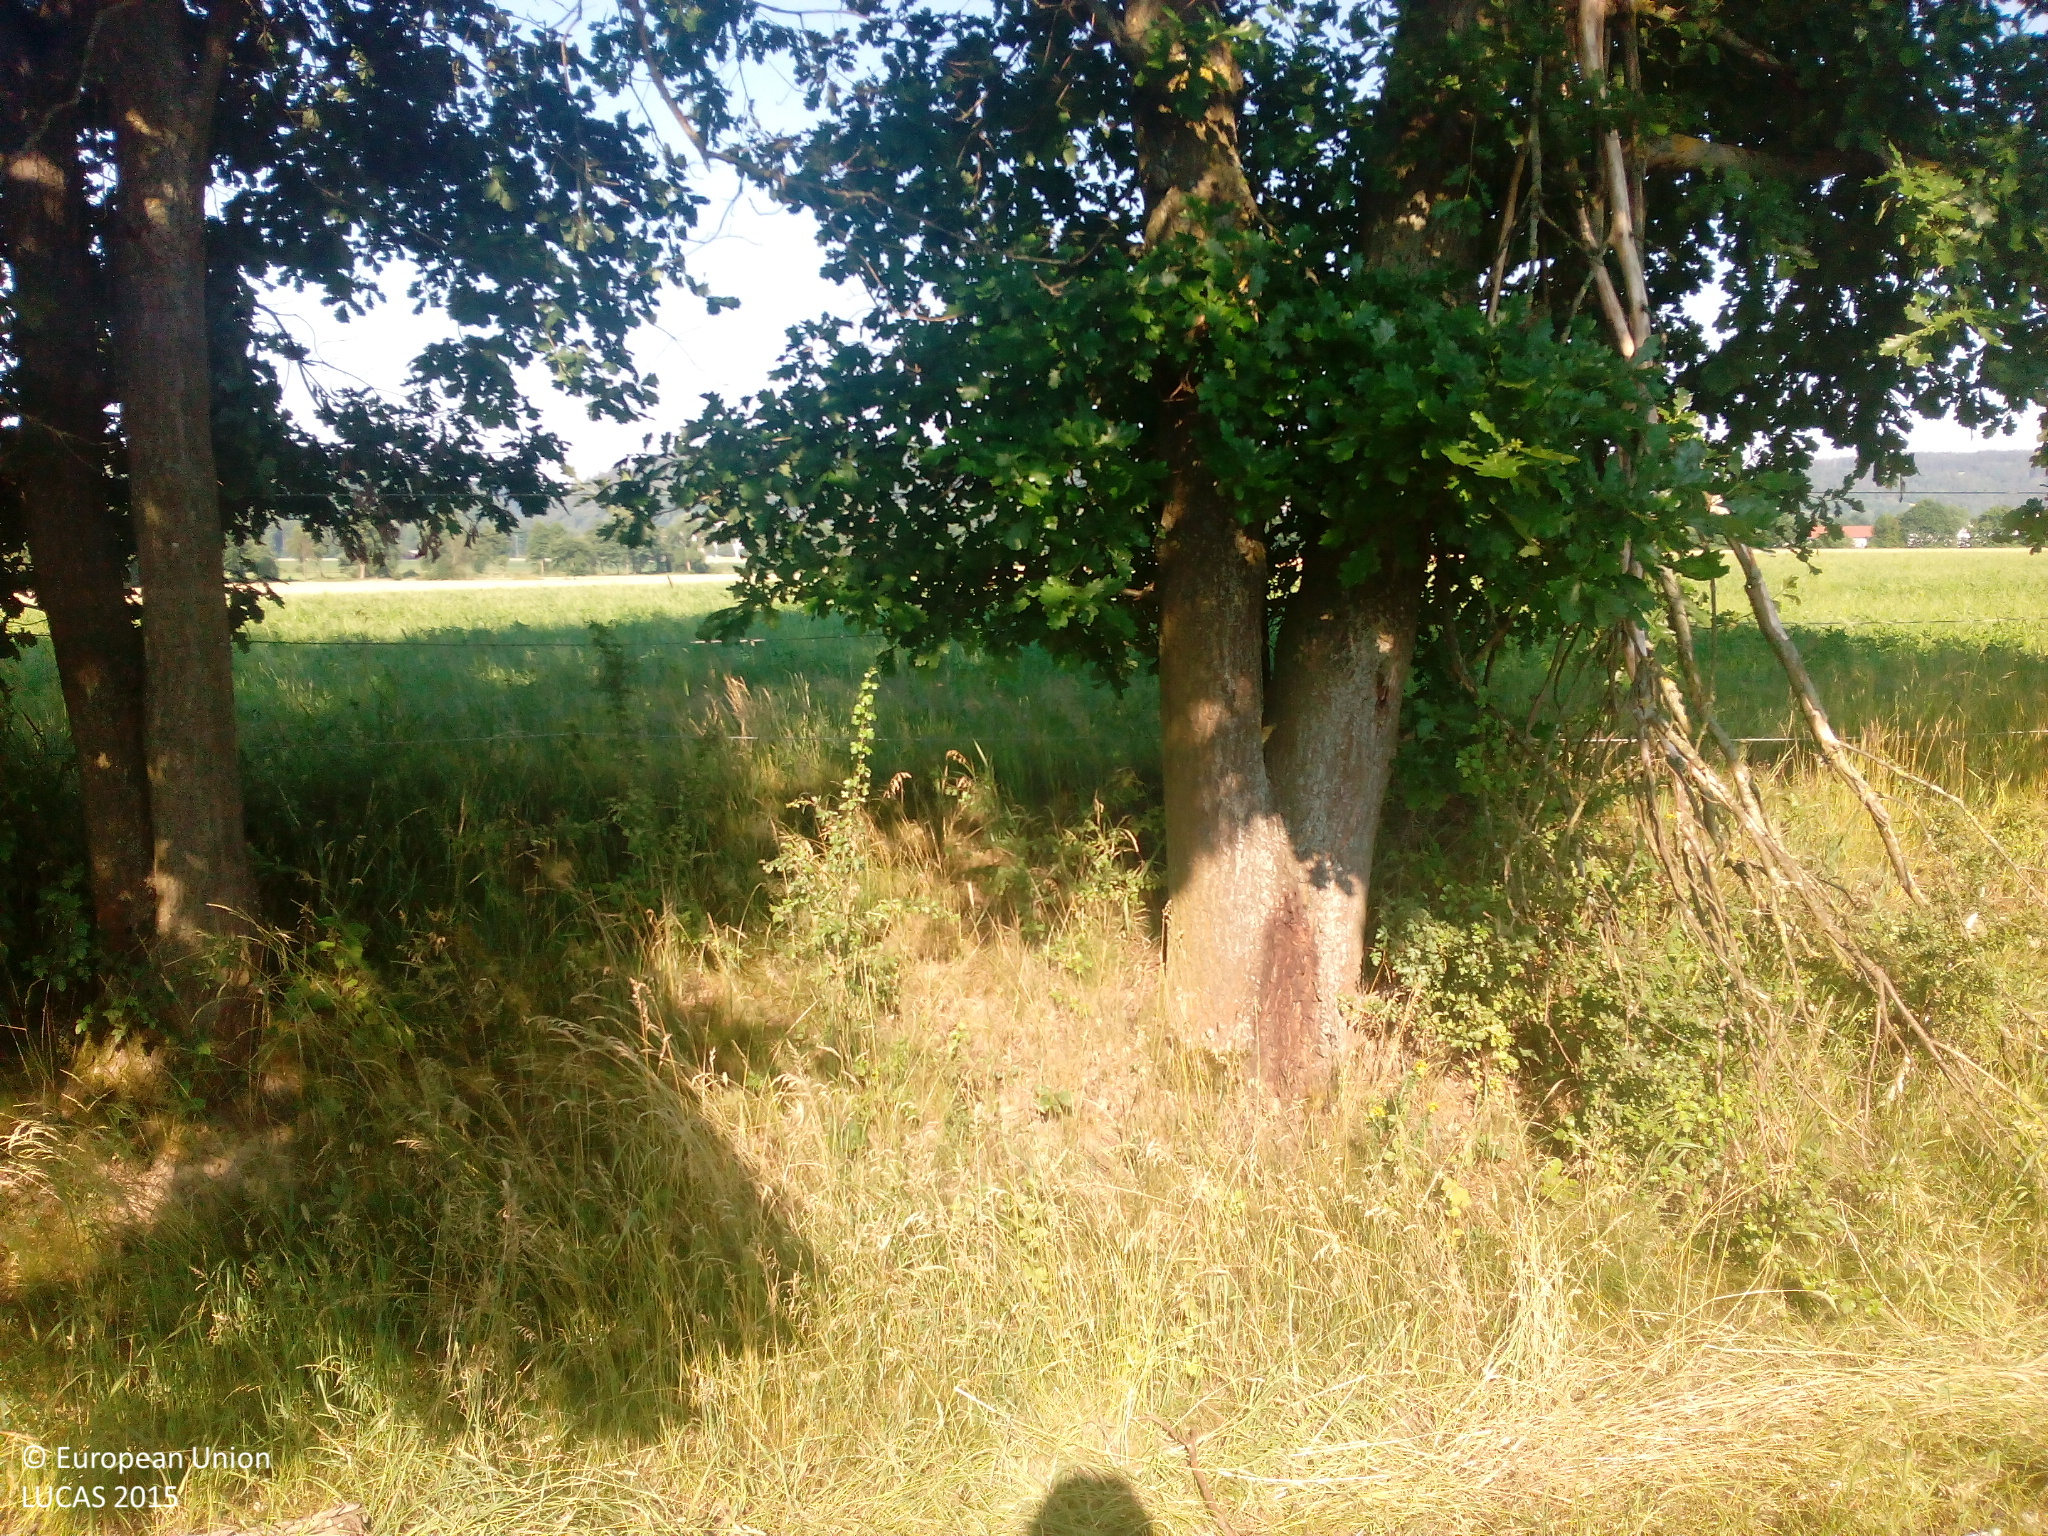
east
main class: Grassland
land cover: Grassland without tree/shrub cover
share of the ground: > 75 %
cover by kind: herbaceous plants 100 %
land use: Agriculture (excluding fallow land and kitchen gardens)
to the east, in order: Grassland without tree/shrub cover; Fences; Grass margins; Tracks; Grass margins; Abandoned hedges; Fences; Grassland without tree/shrub cover; Fences; Grassland without tree/shrub cover; Tracks; Grass margins; Barley
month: July
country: DE
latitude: 50.1014
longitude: 11.5794
